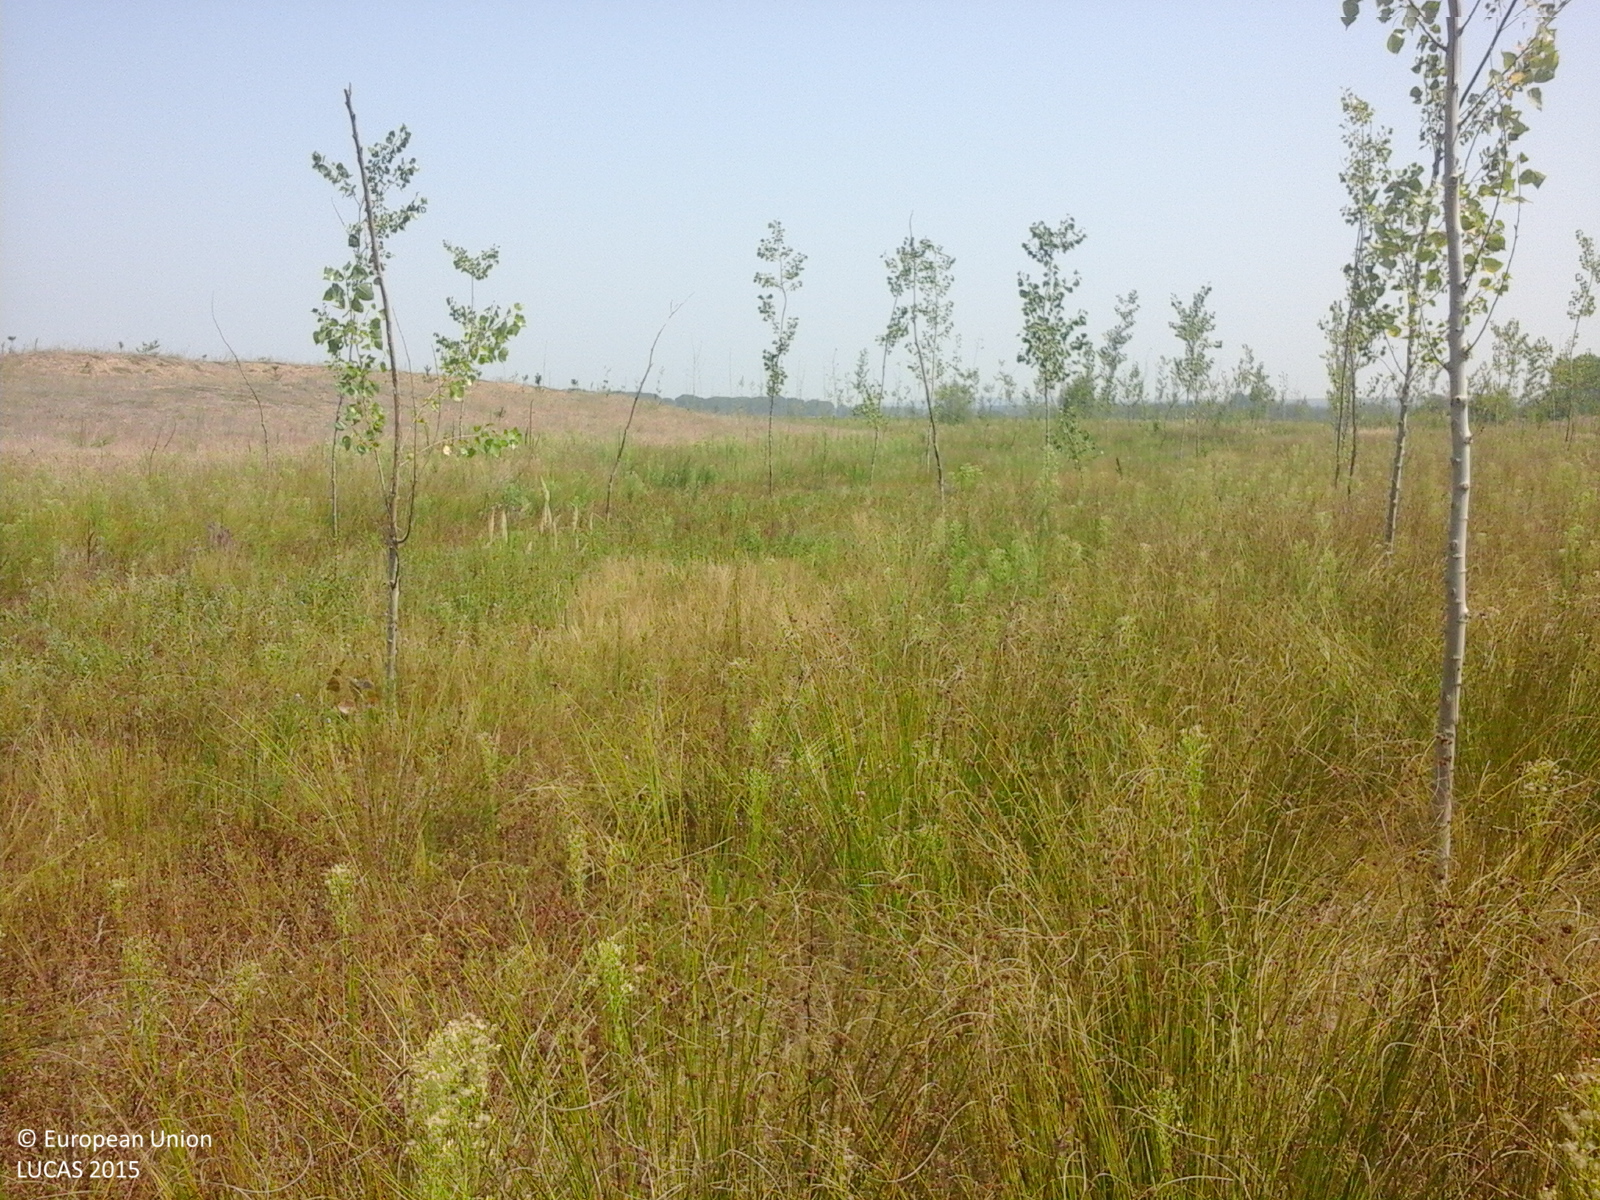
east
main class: Cropland
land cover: Nurseries
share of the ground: > 75 %
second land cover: Spontaneously vegetated surfaces
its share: > 75 %
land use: Agriculture (excluding fallow land and kitchen gardens)
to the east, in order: Nurseries; Spontaneously vegetated surfaces; Inland marshes
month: August
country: RO
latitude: 43.8396
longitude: 23.1388
